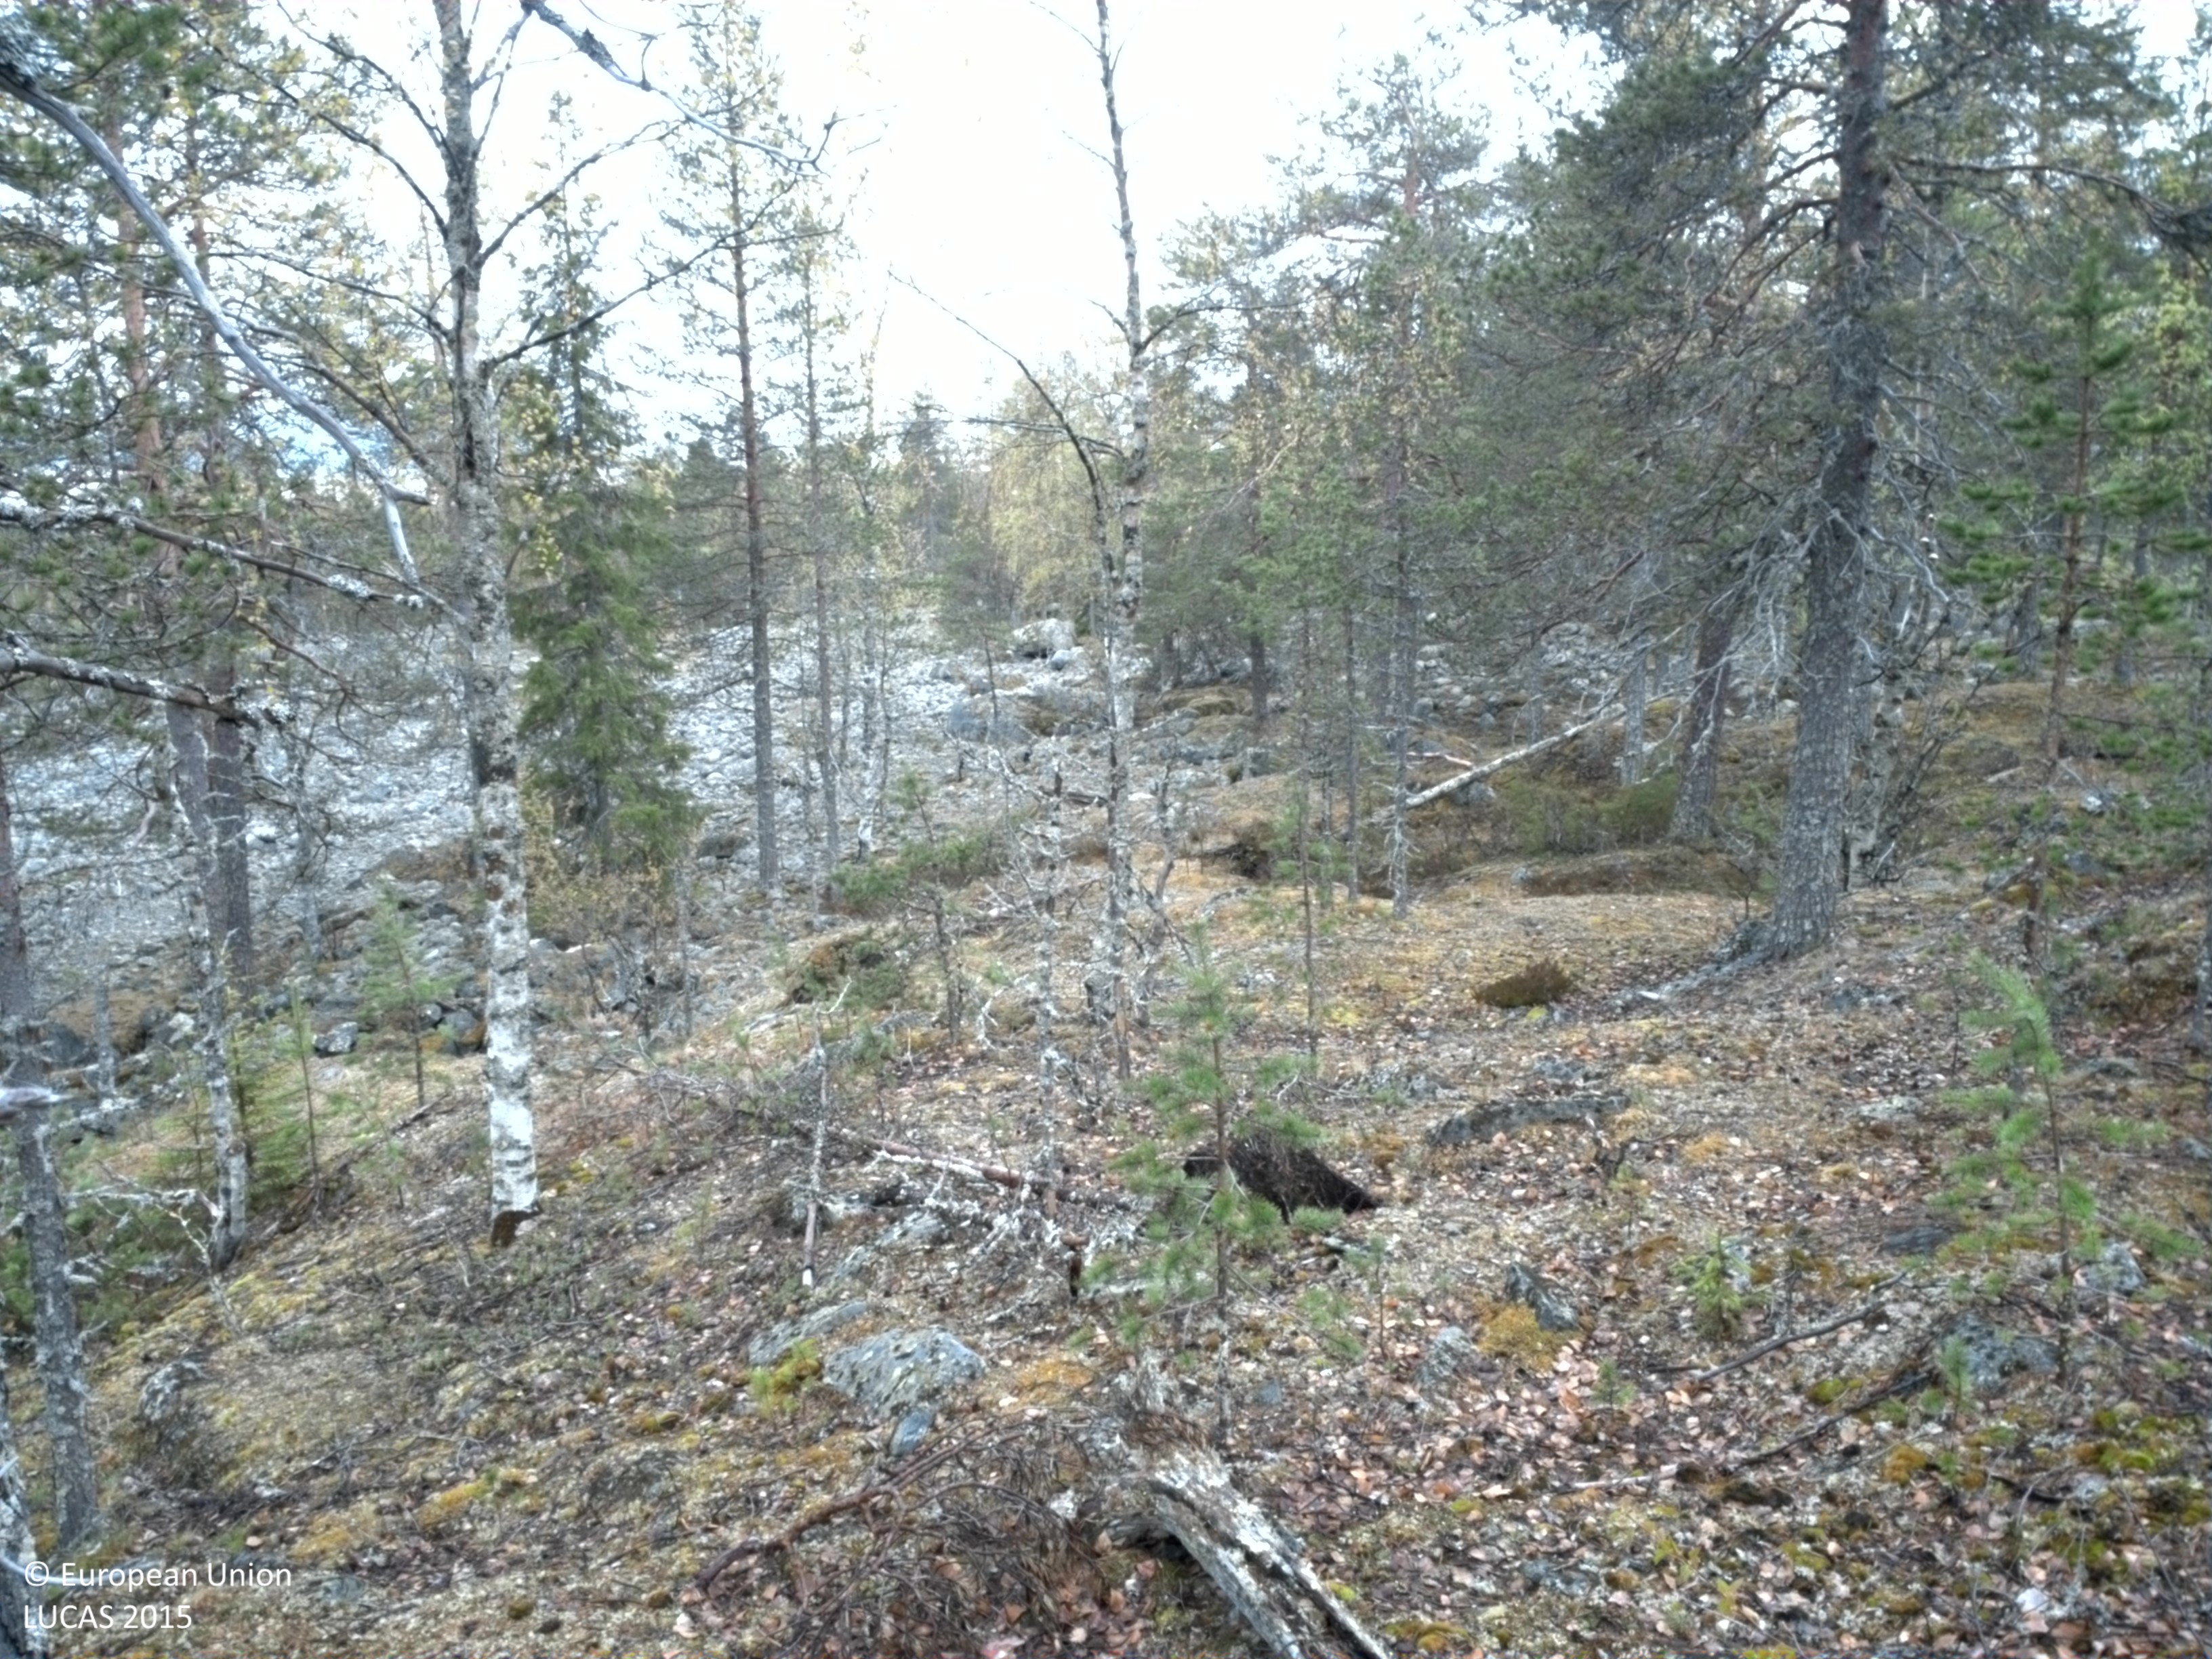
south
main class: Woodland
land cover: Pine dominated coniferous woodland
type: boreal forest
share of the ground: 25 - 50 %
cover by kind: coniferous forest trees 40 %, lichens and mosses 40 %, consolidated bare surface 10 %, broadleaved forest trees 5 %, shrubs 5 %
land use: Semi-natural and natural areas not in use
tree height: > 5 m
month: May
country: SE
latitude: 66.0593
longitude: 23.0806
